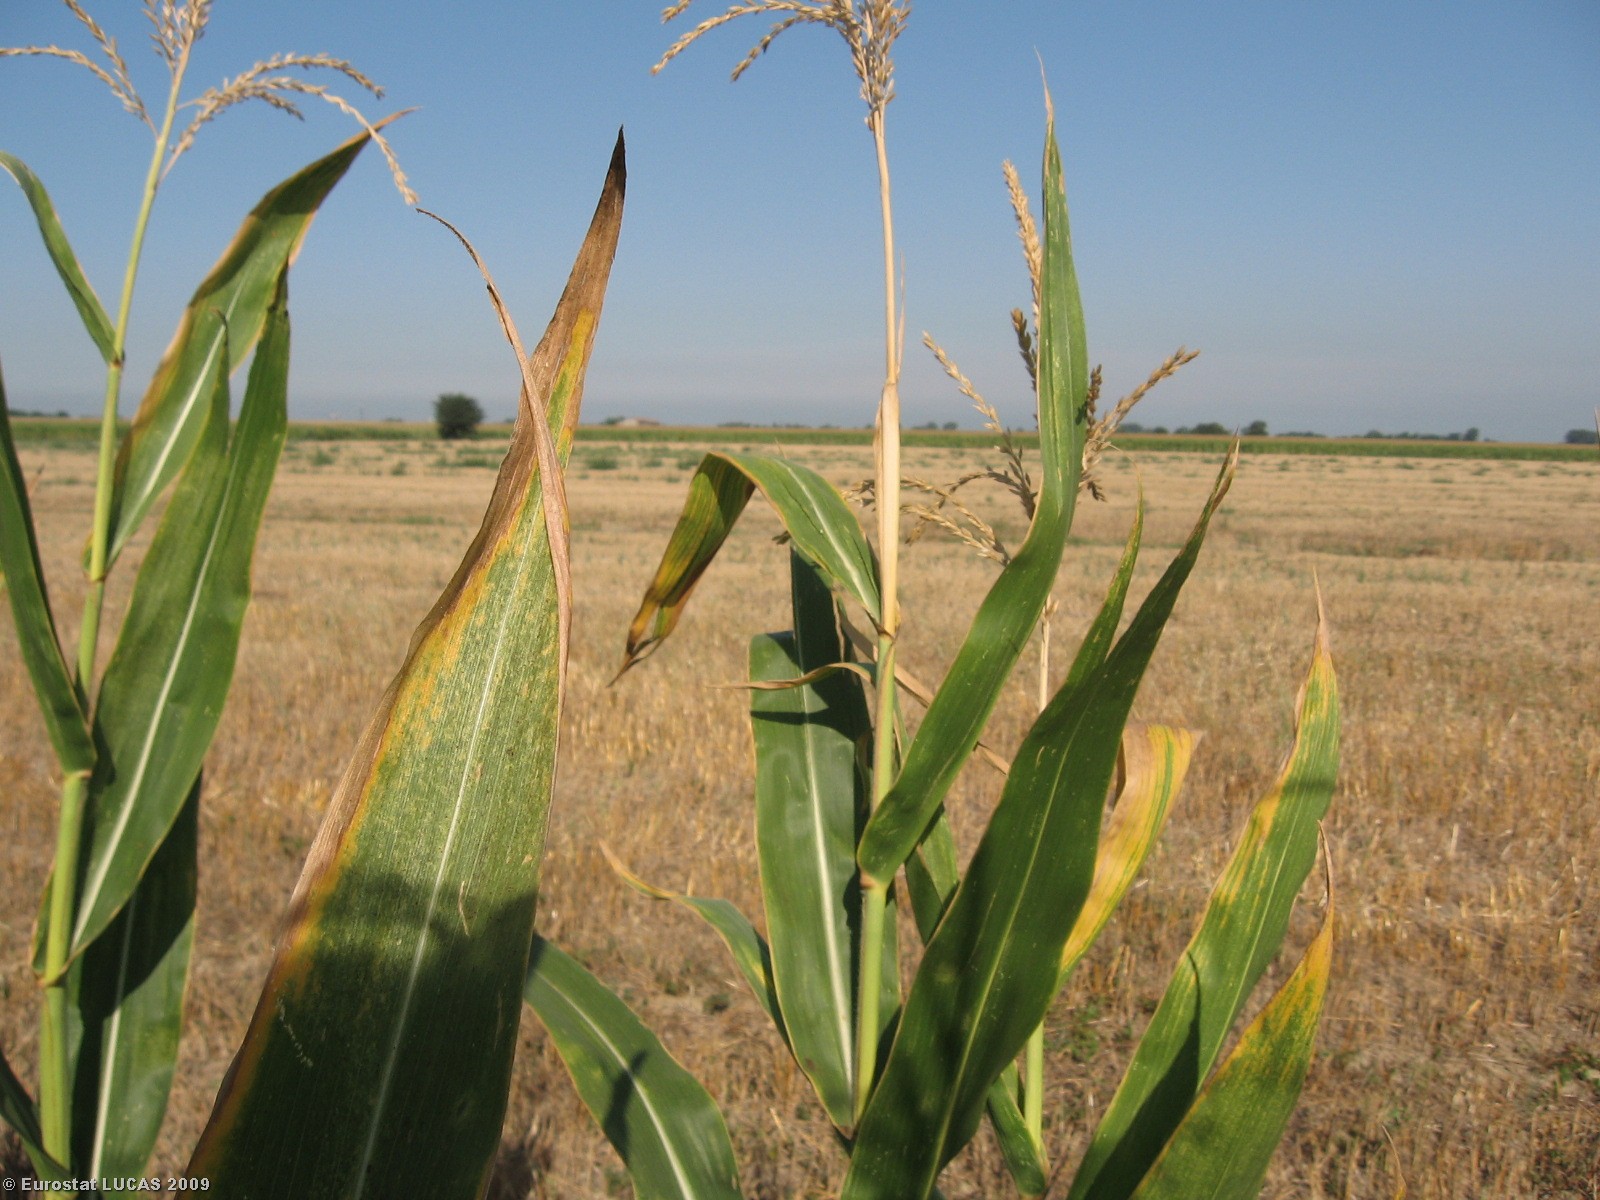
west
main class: Cropland
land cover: Maize
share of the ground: > 75 %
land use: Agriculture (excluding fallow land and kitchen gardens)
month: August
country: IT
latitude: 45.0177
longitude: 10.0380
